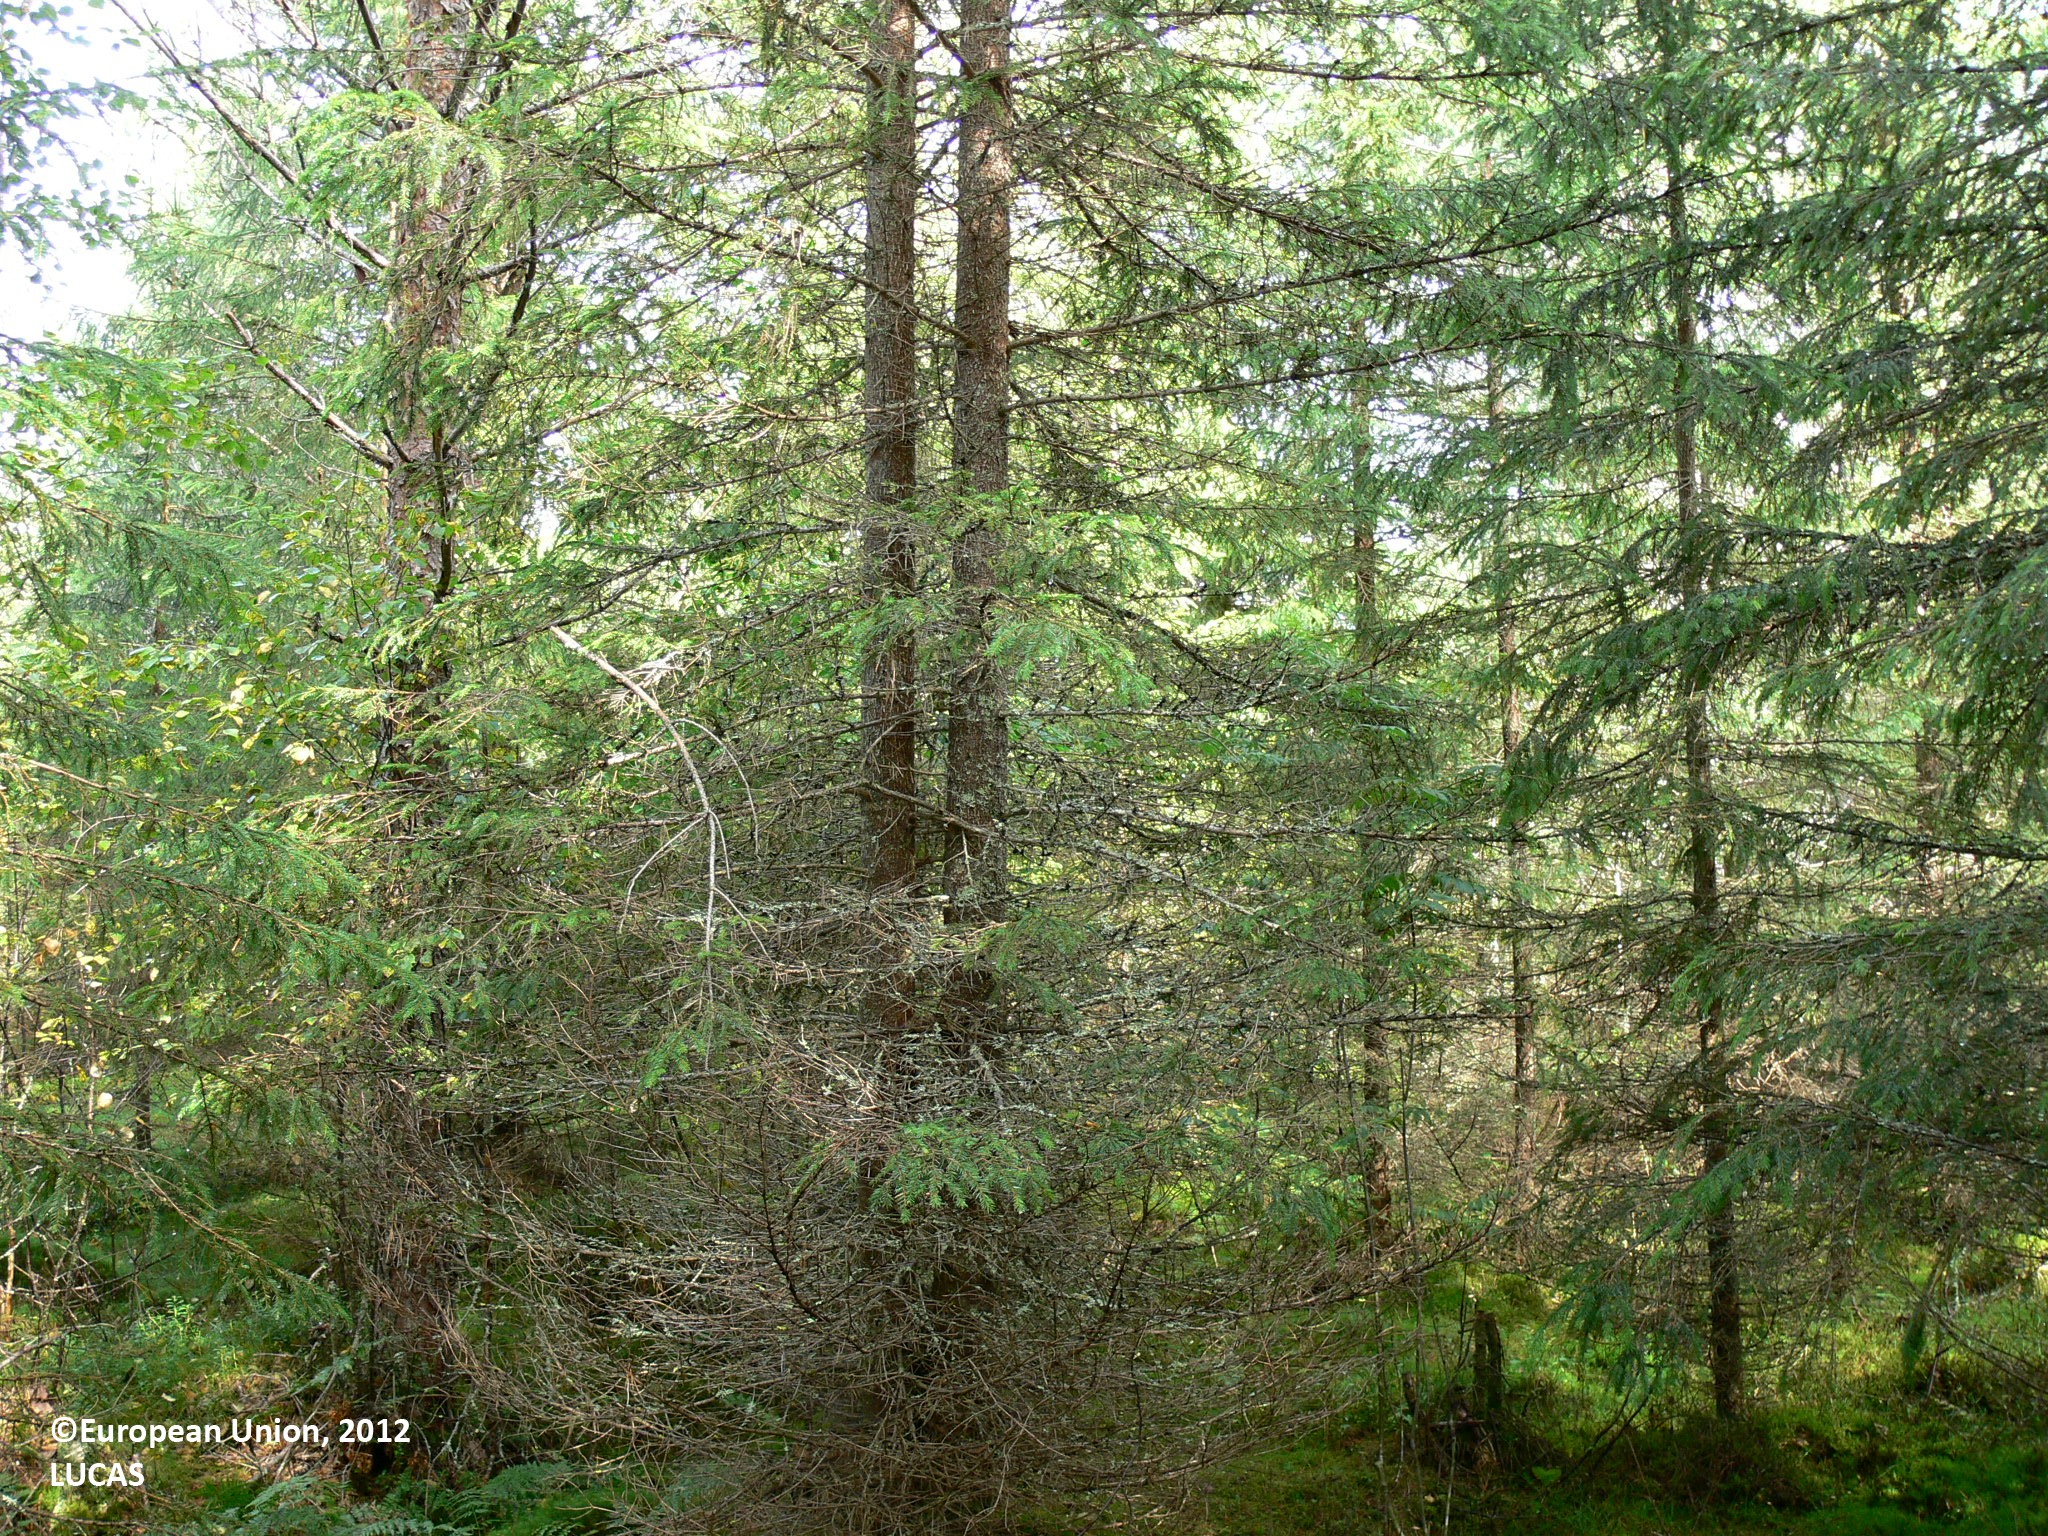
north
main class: Woodland
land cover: Other coniferous woodland
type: boreal forest
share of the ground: > 75 %
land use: Forestry
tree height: > 5 m
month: August
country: FI
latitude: 61.7170
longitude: 29.8434
